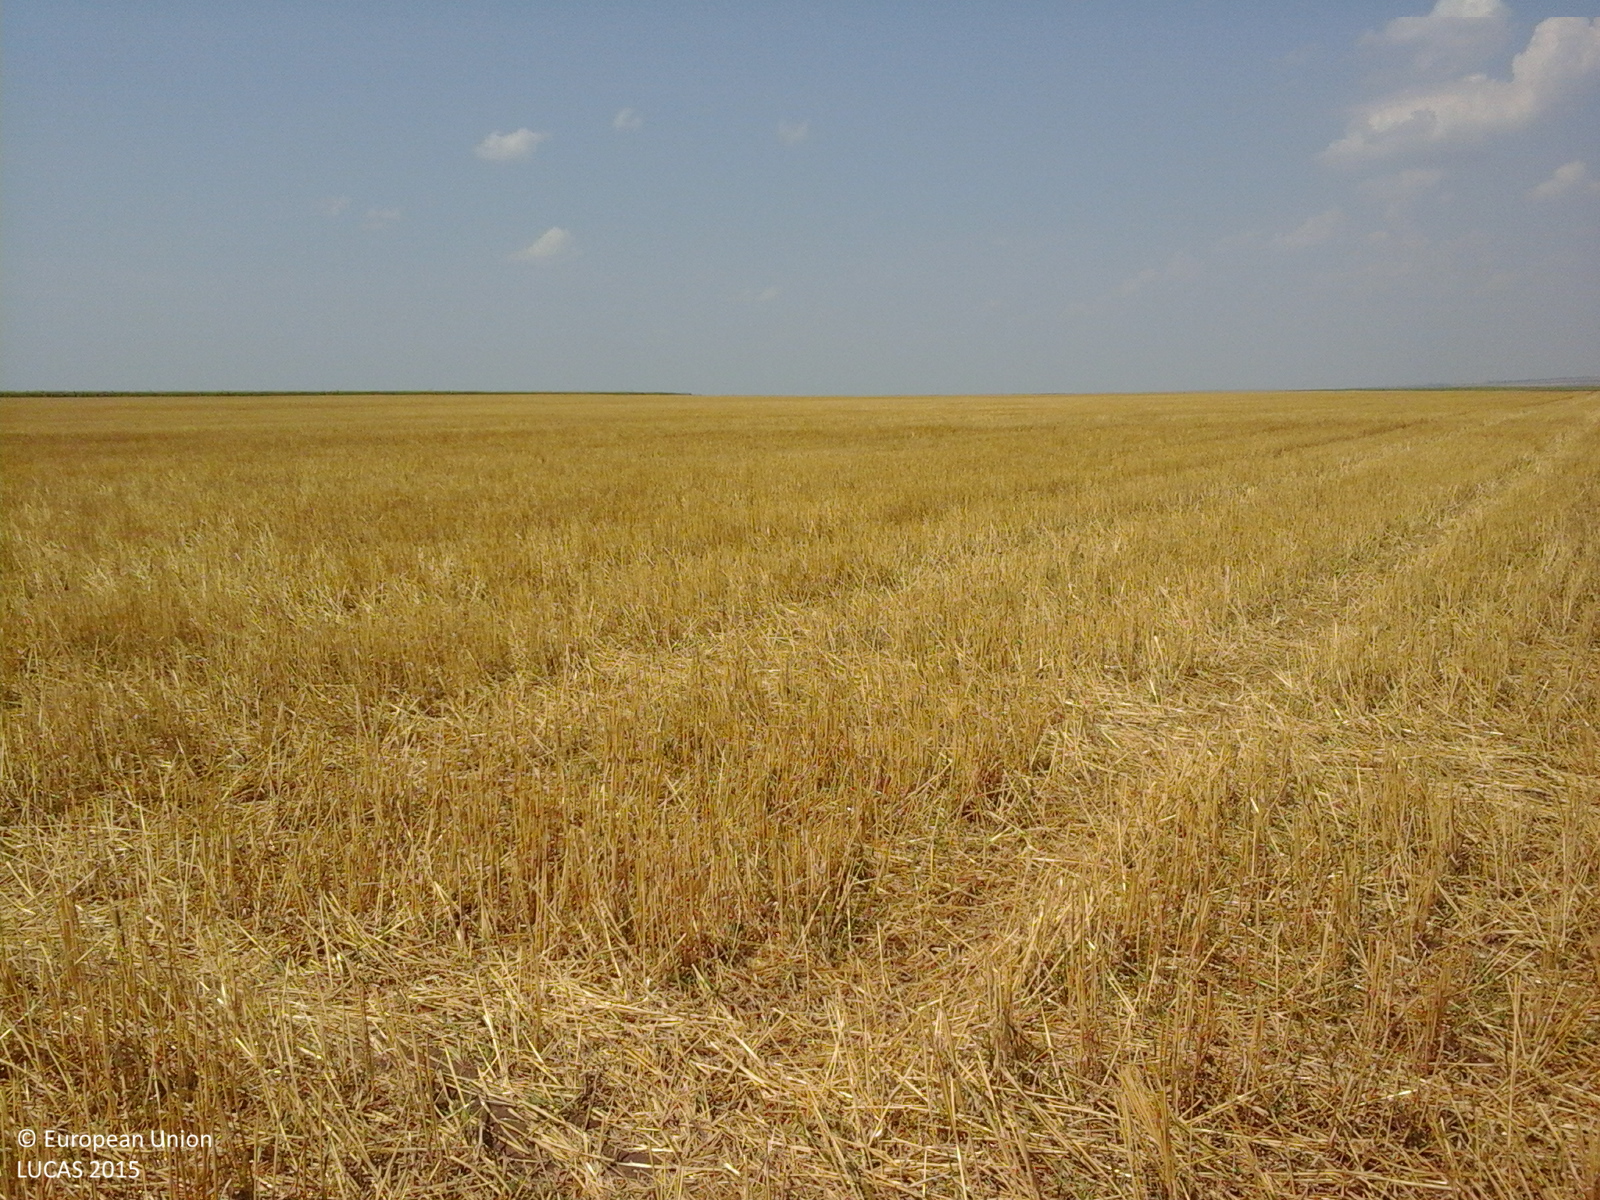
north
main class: Cropland
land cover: Common wheat
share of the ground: > 75 %
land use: Agriculture (excluding fallow land and kitchen gardens)
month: July
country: RO
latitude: 45.8990
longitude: 27.5460
